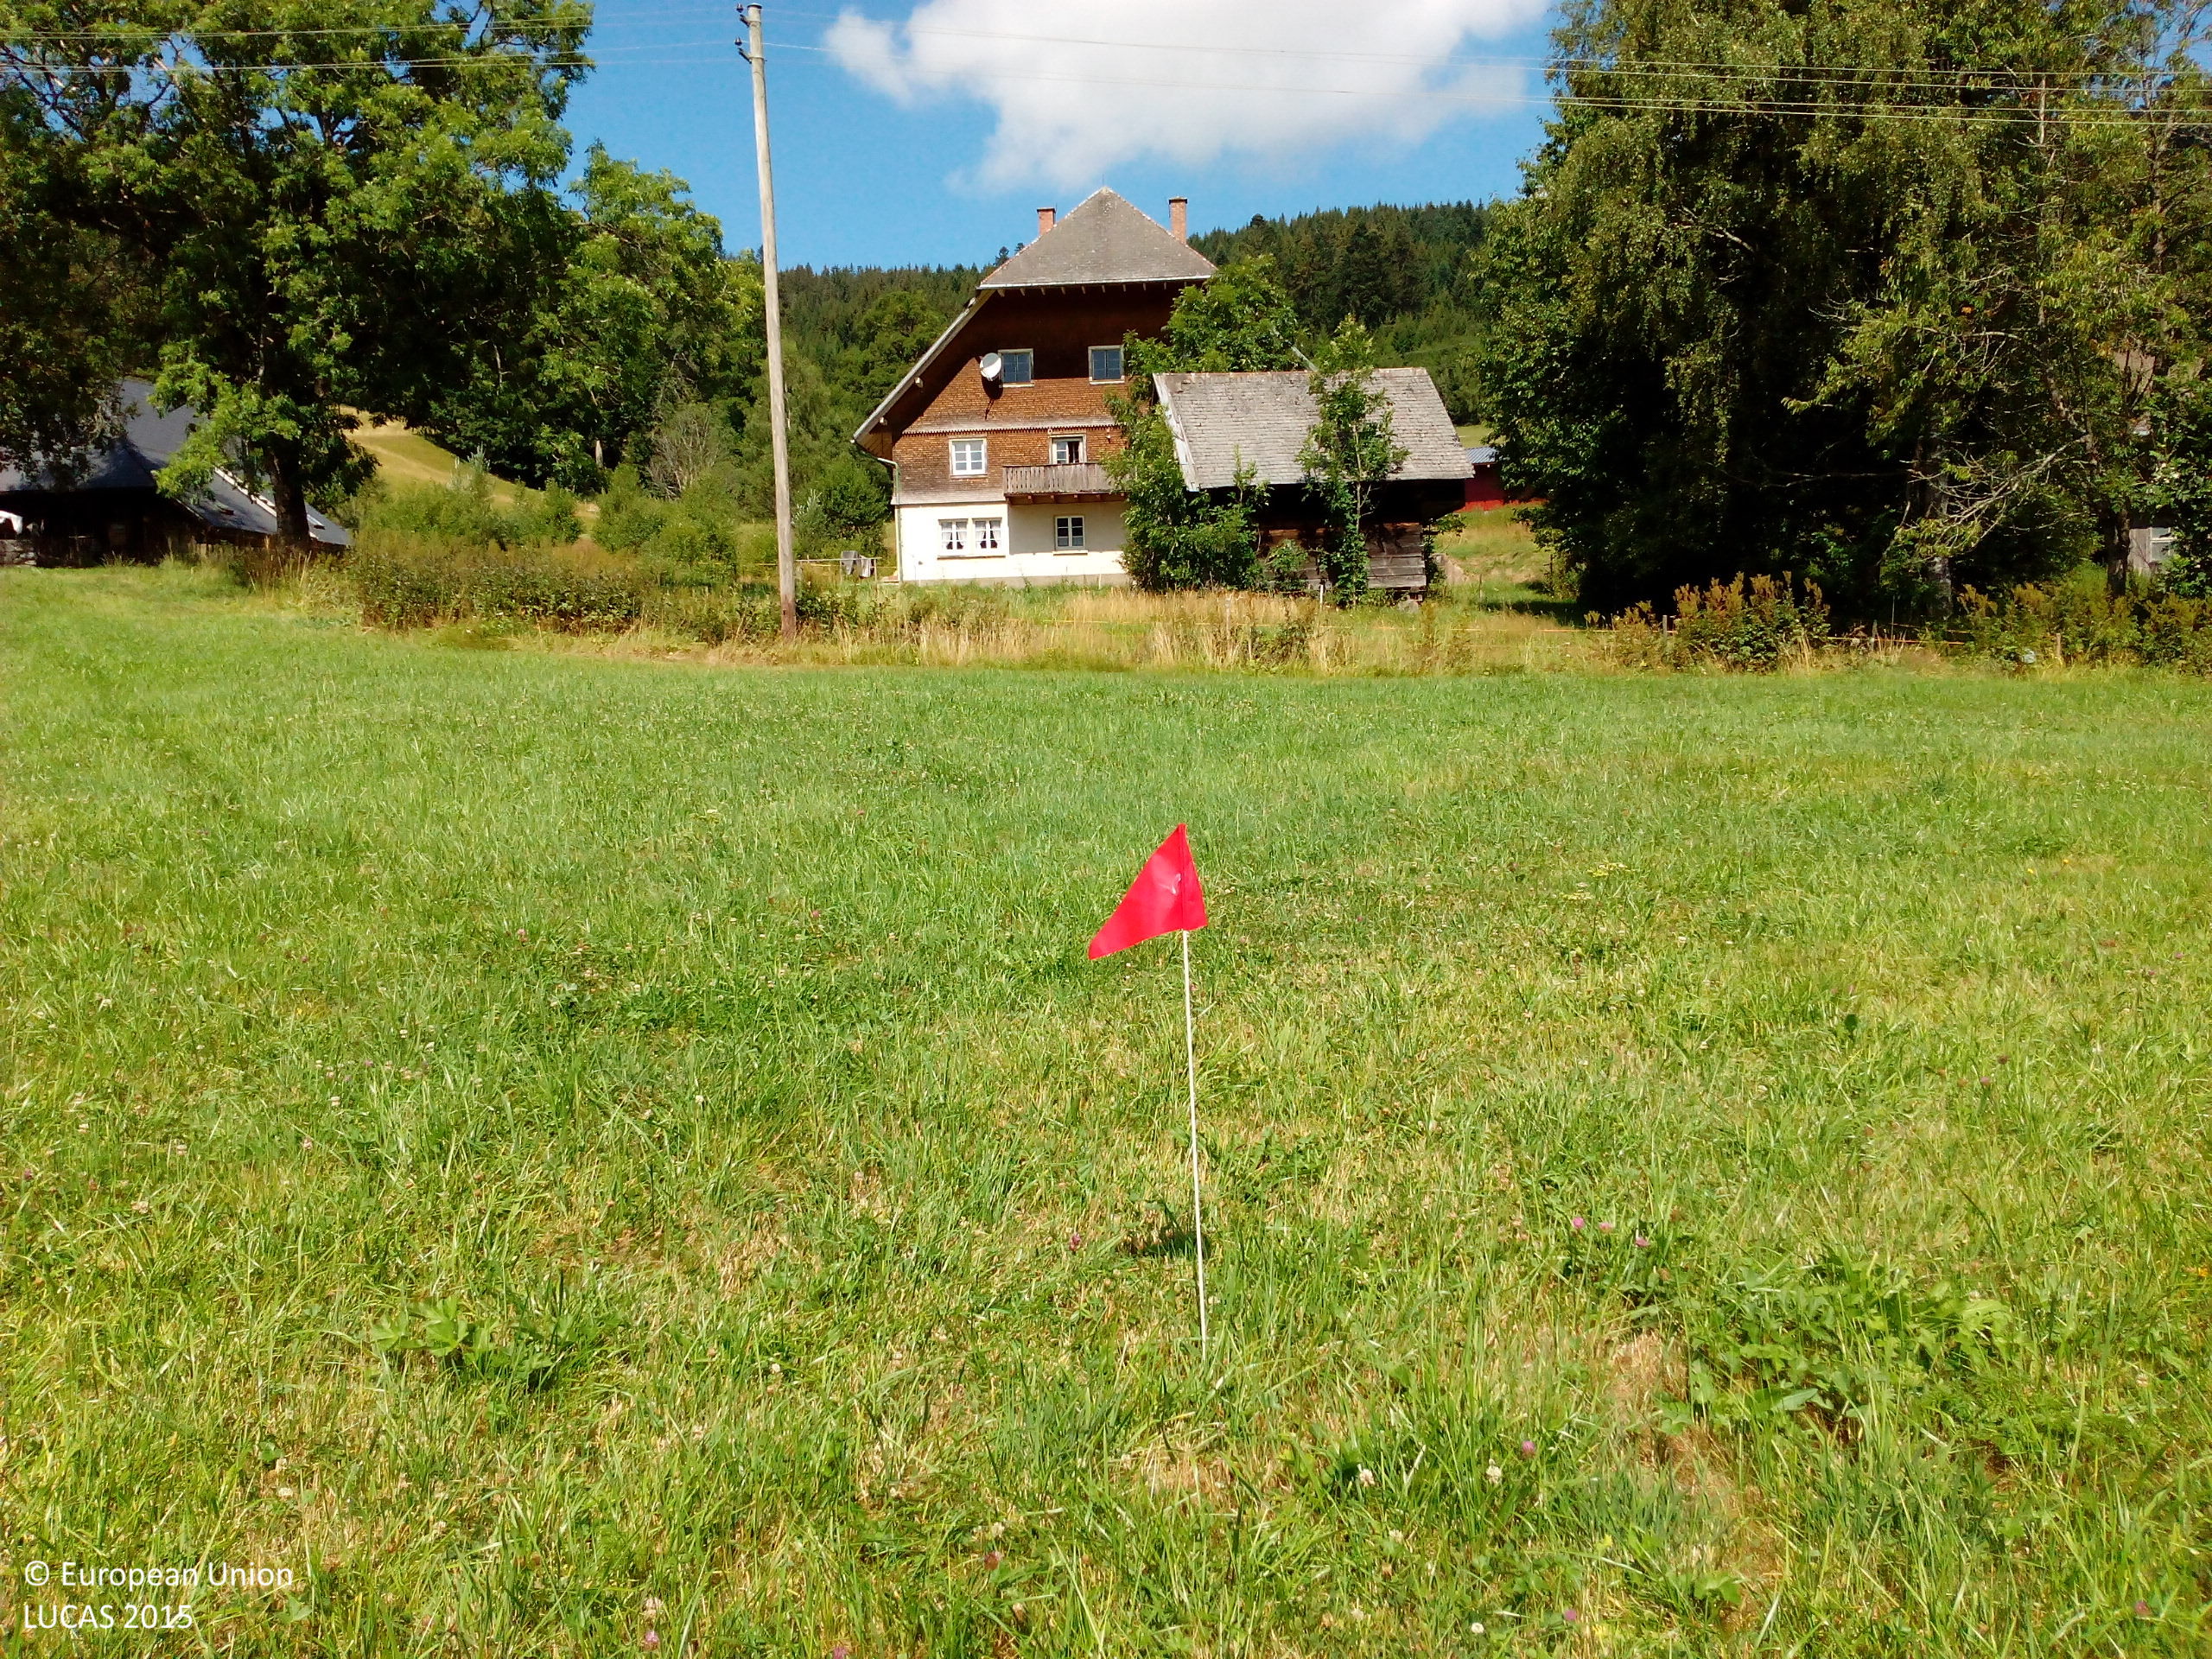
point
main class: Grassland
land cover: Grassland without tree/shrub cover
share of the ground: > 75 %
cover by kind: herbaceous plants 100 %
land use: Agriculture (excluding fallow land and kitchen gardens)
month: August
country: DE
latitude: 47.9387
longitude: 8.1939
